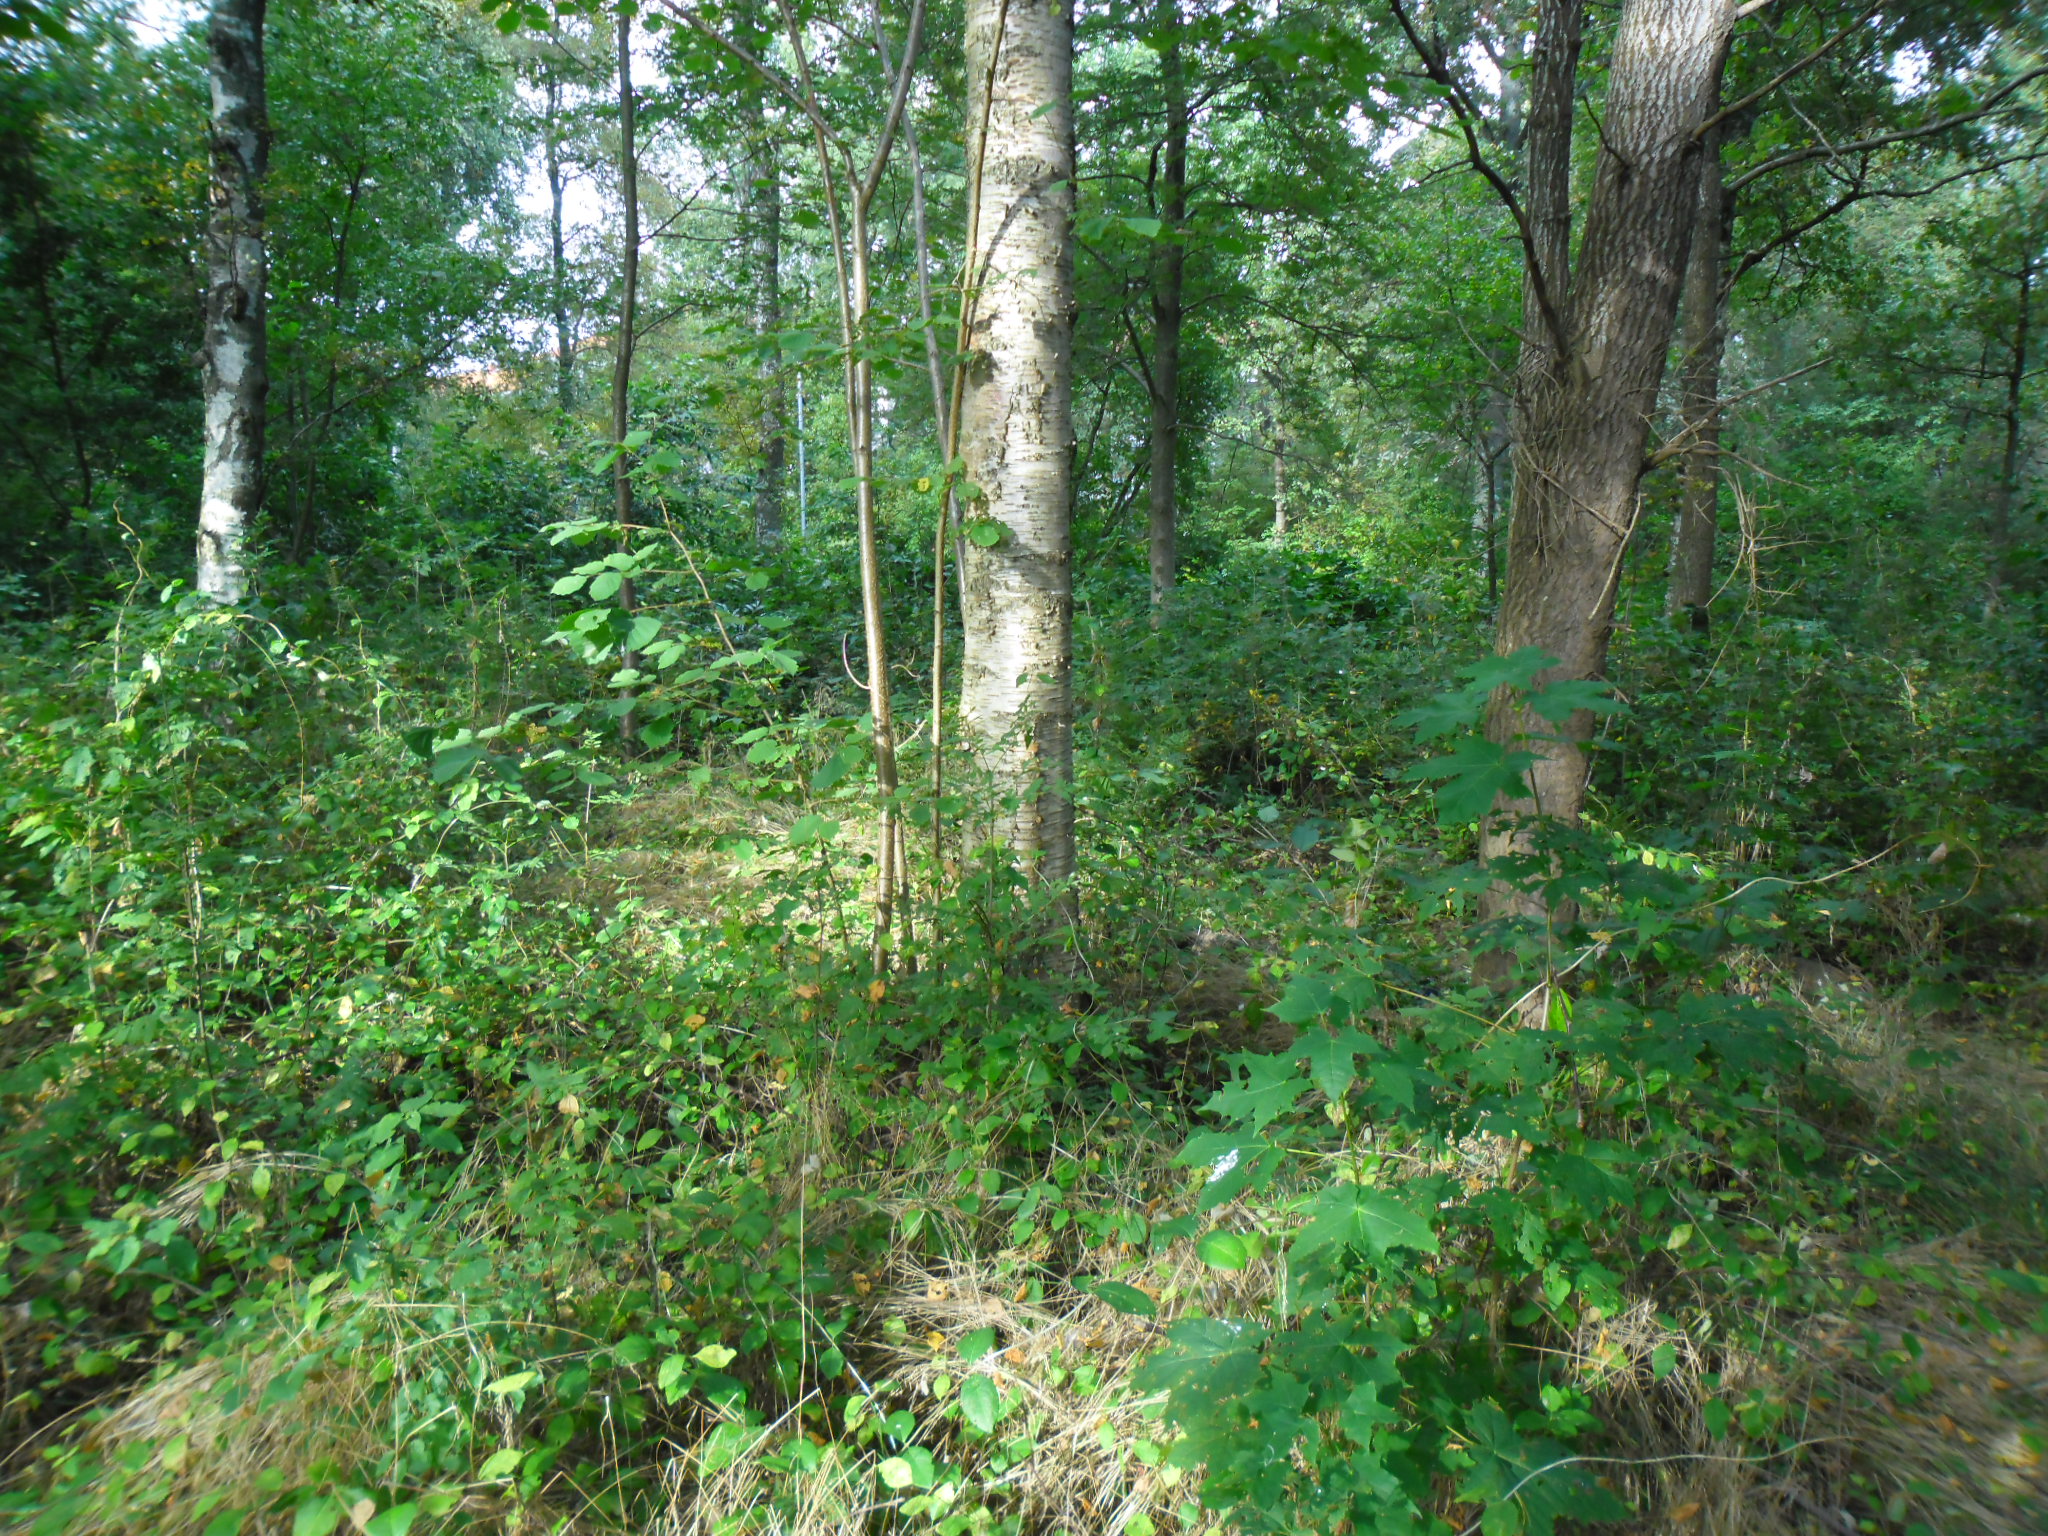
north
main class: Woodland
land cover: Broadleaved woodland
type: non-riverine alder, birch or aspen forest
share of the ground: 50 - 75 %
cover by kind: broadleaved forest trees 70 %, herbaceous plants 30 %
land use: Residential
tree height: > 5 m
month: October
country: SE
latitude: 56.6612
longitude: 12.7868
